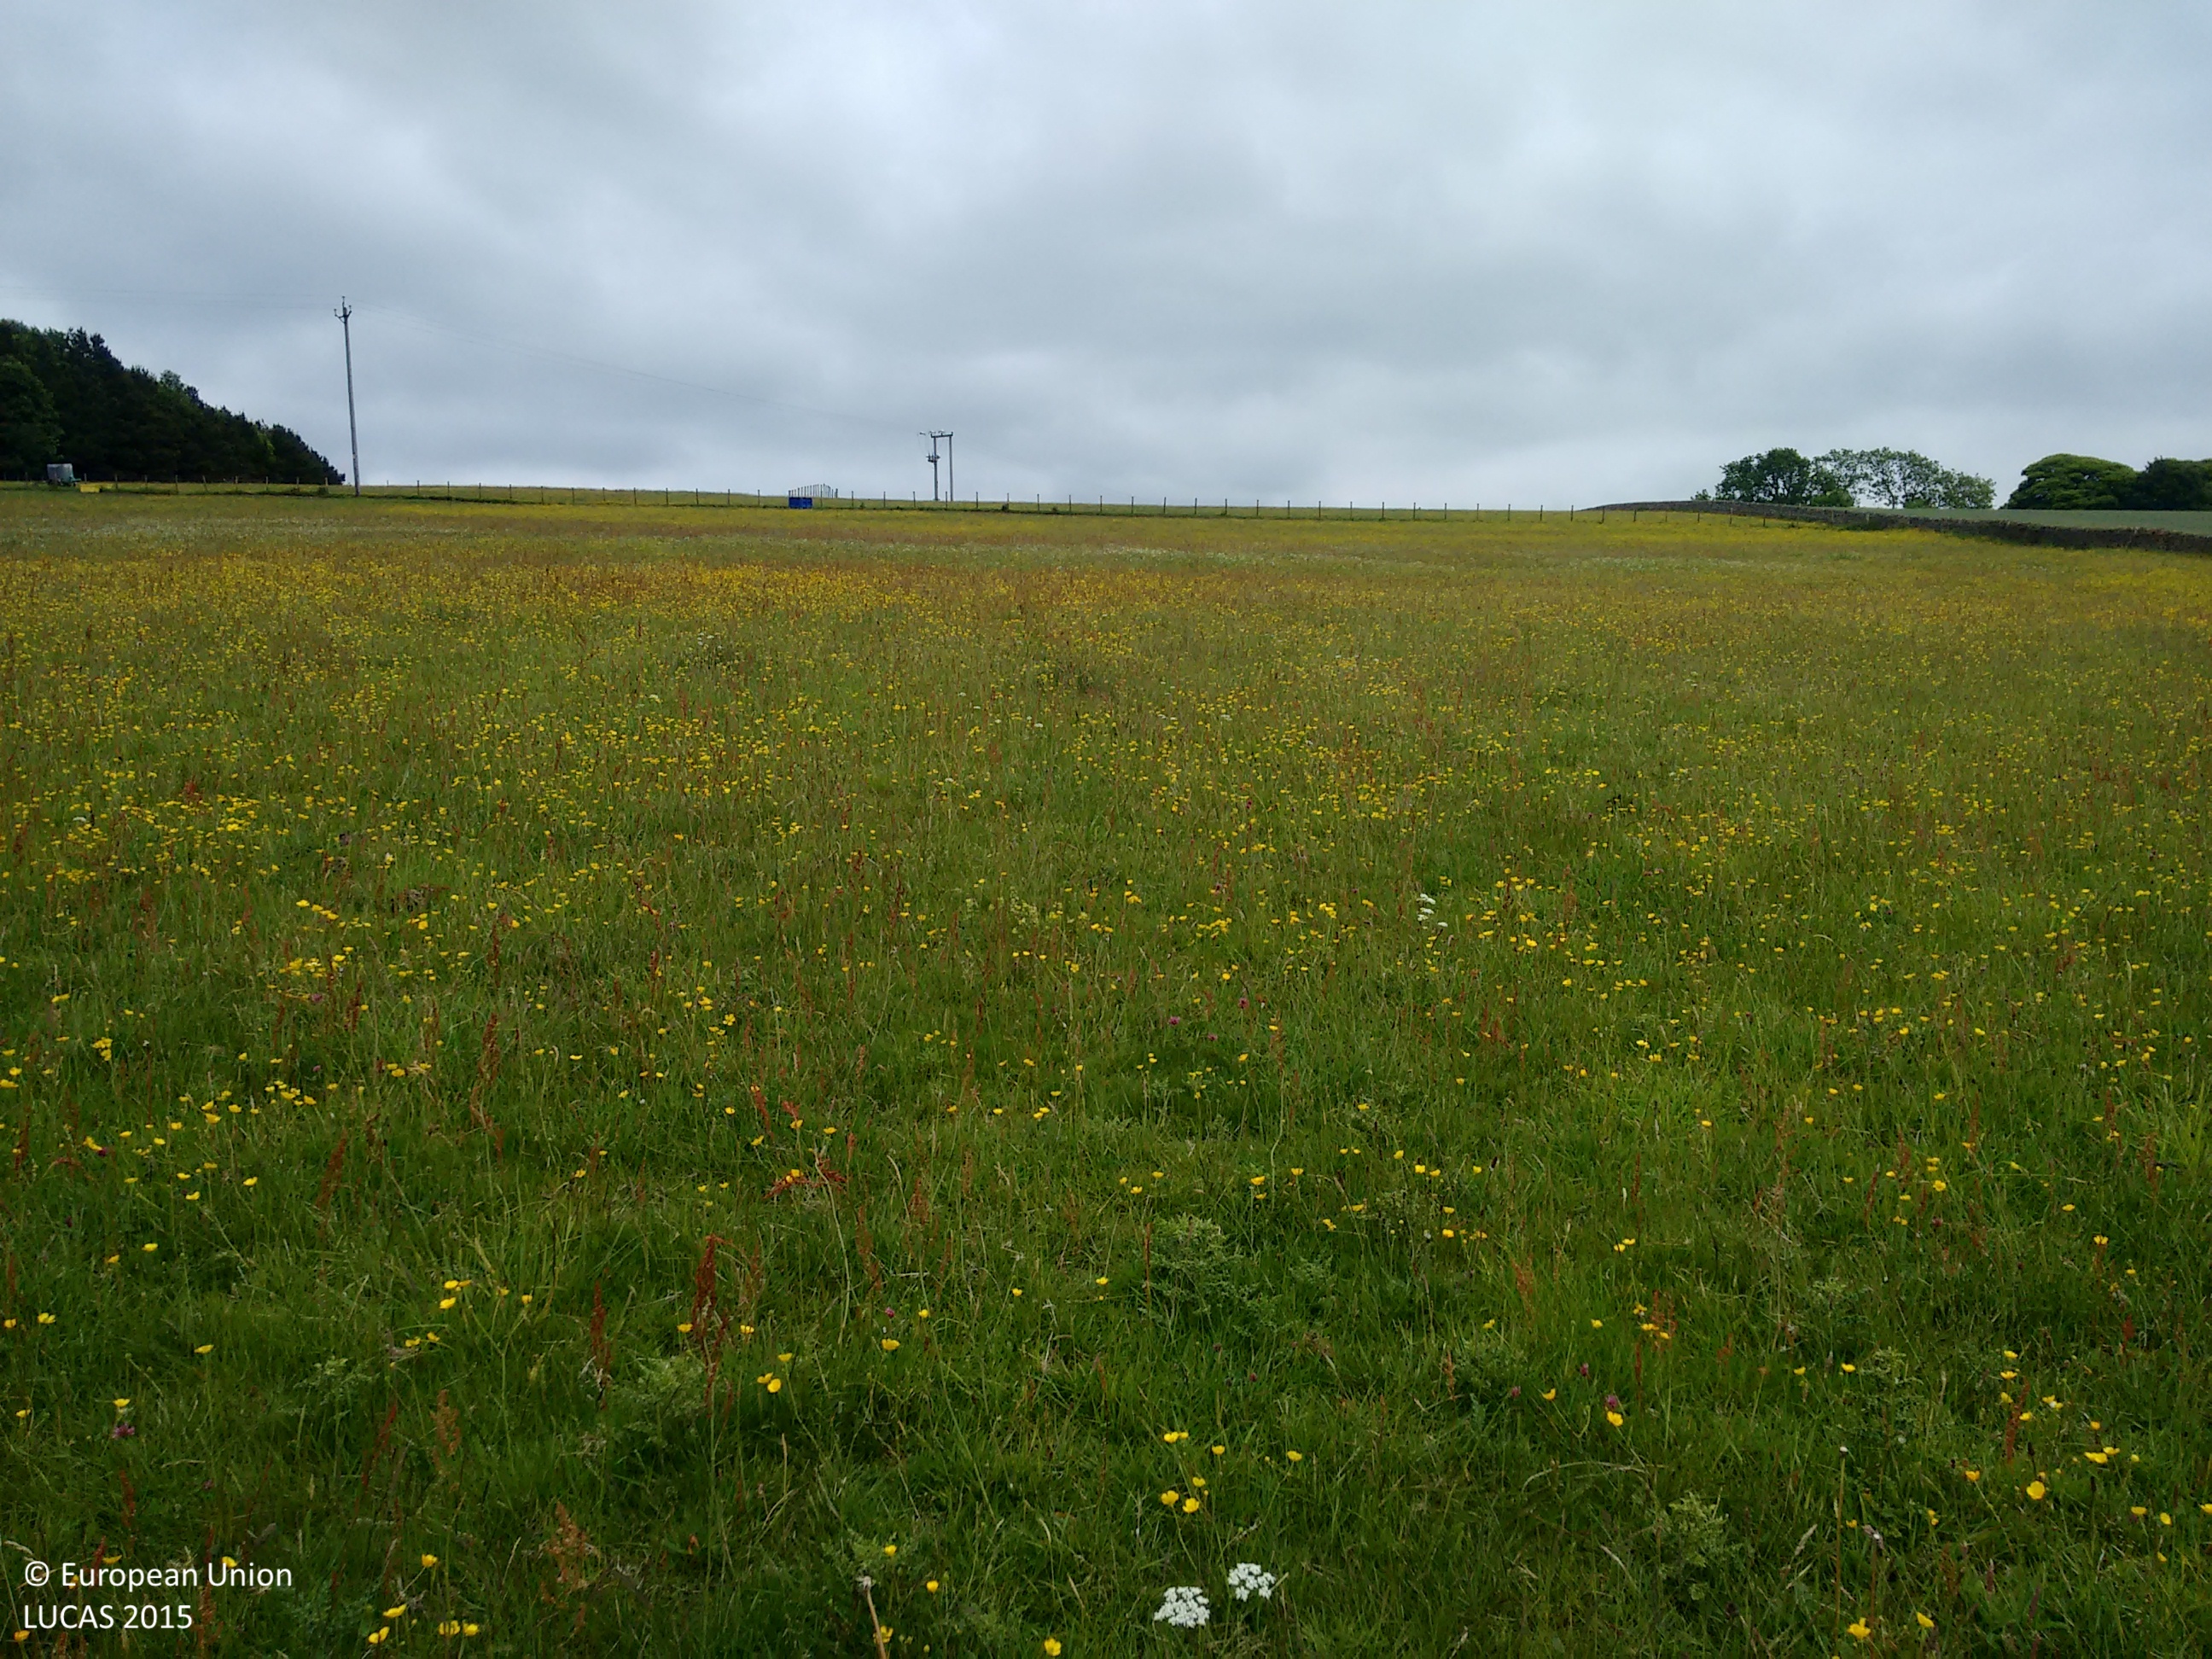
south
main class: Grassland
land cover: Grassland without tree/shrub cover
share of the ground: > 75 %
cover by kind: herbaceous plants 100 %
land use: Agriculture (excluding fallow land and kitchen gardens)
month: June
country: GB
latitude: 54.8252
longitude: -1.7723
